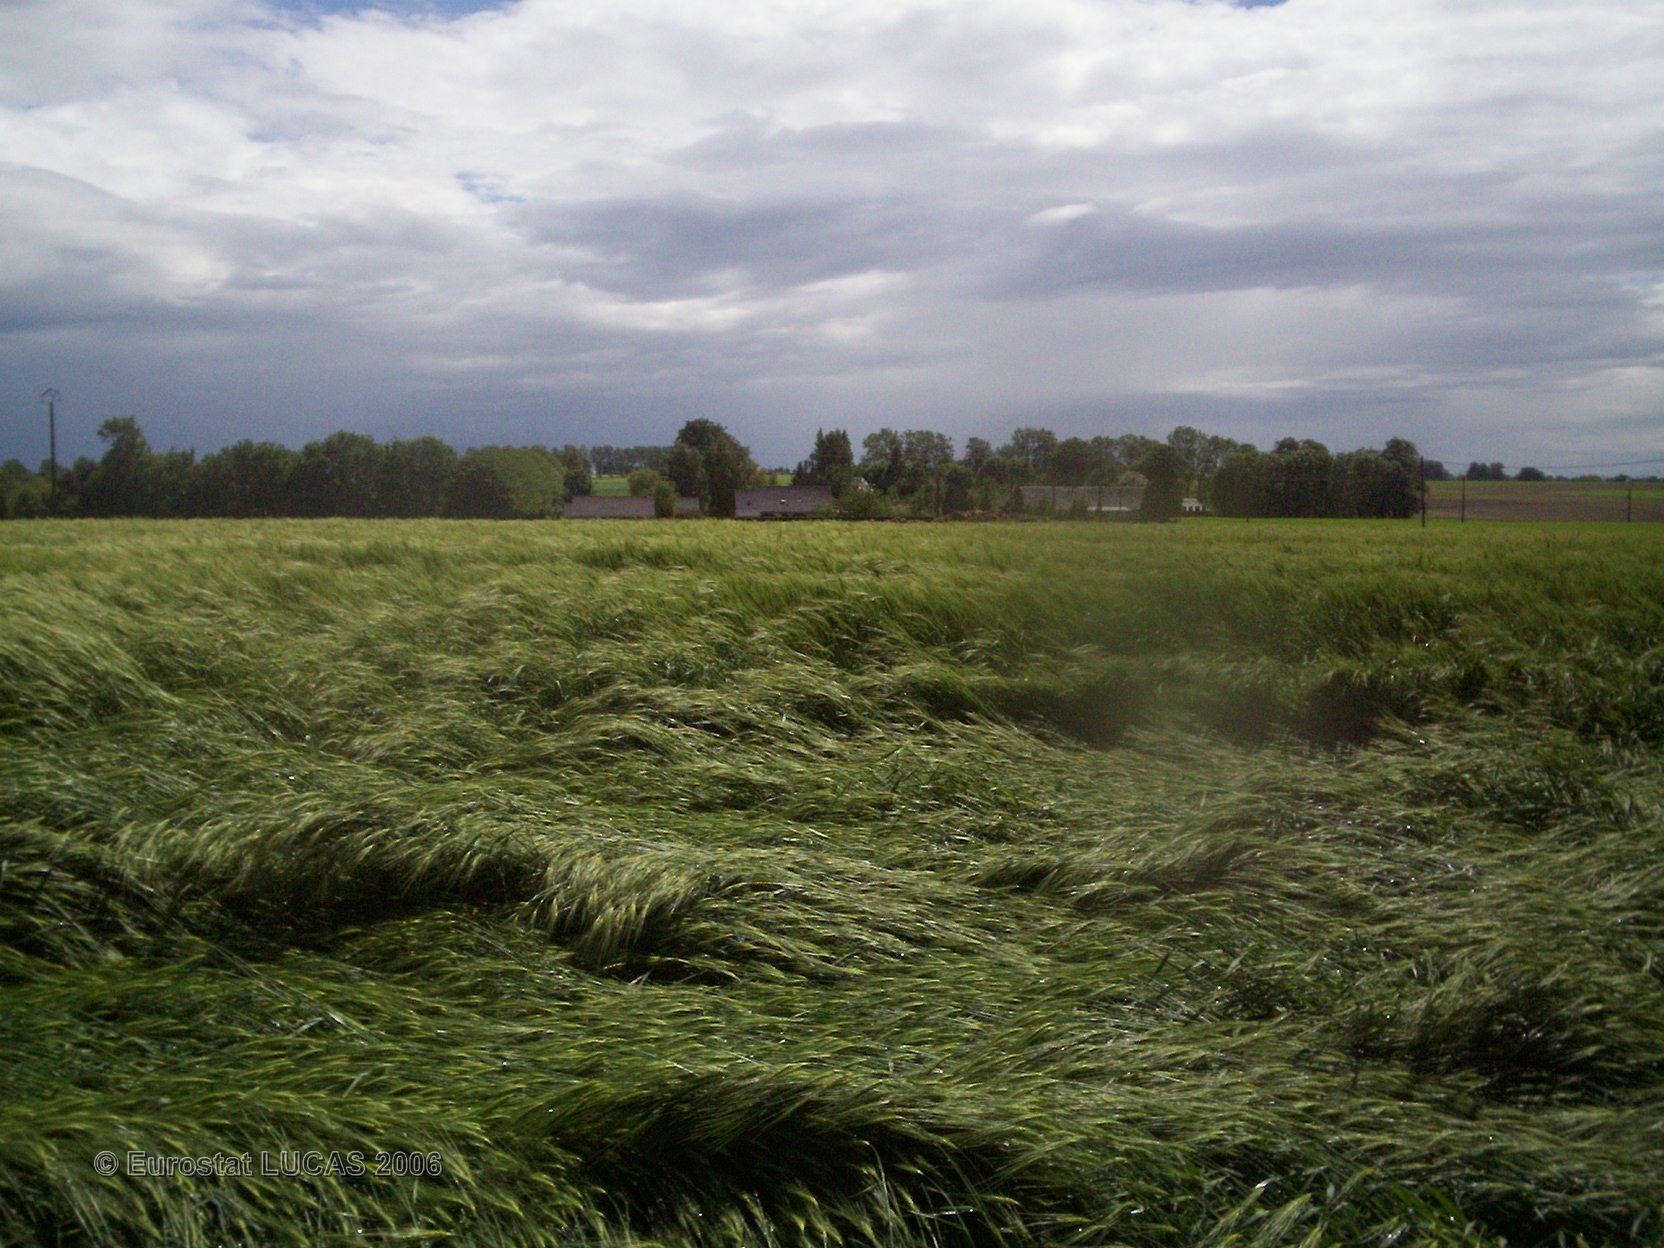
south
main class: Cropland
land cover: Barley
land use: Agriculture (excluding fallow land and kitchen gardens)
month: May
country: FR
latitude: 49.5448
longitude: 0.4225
